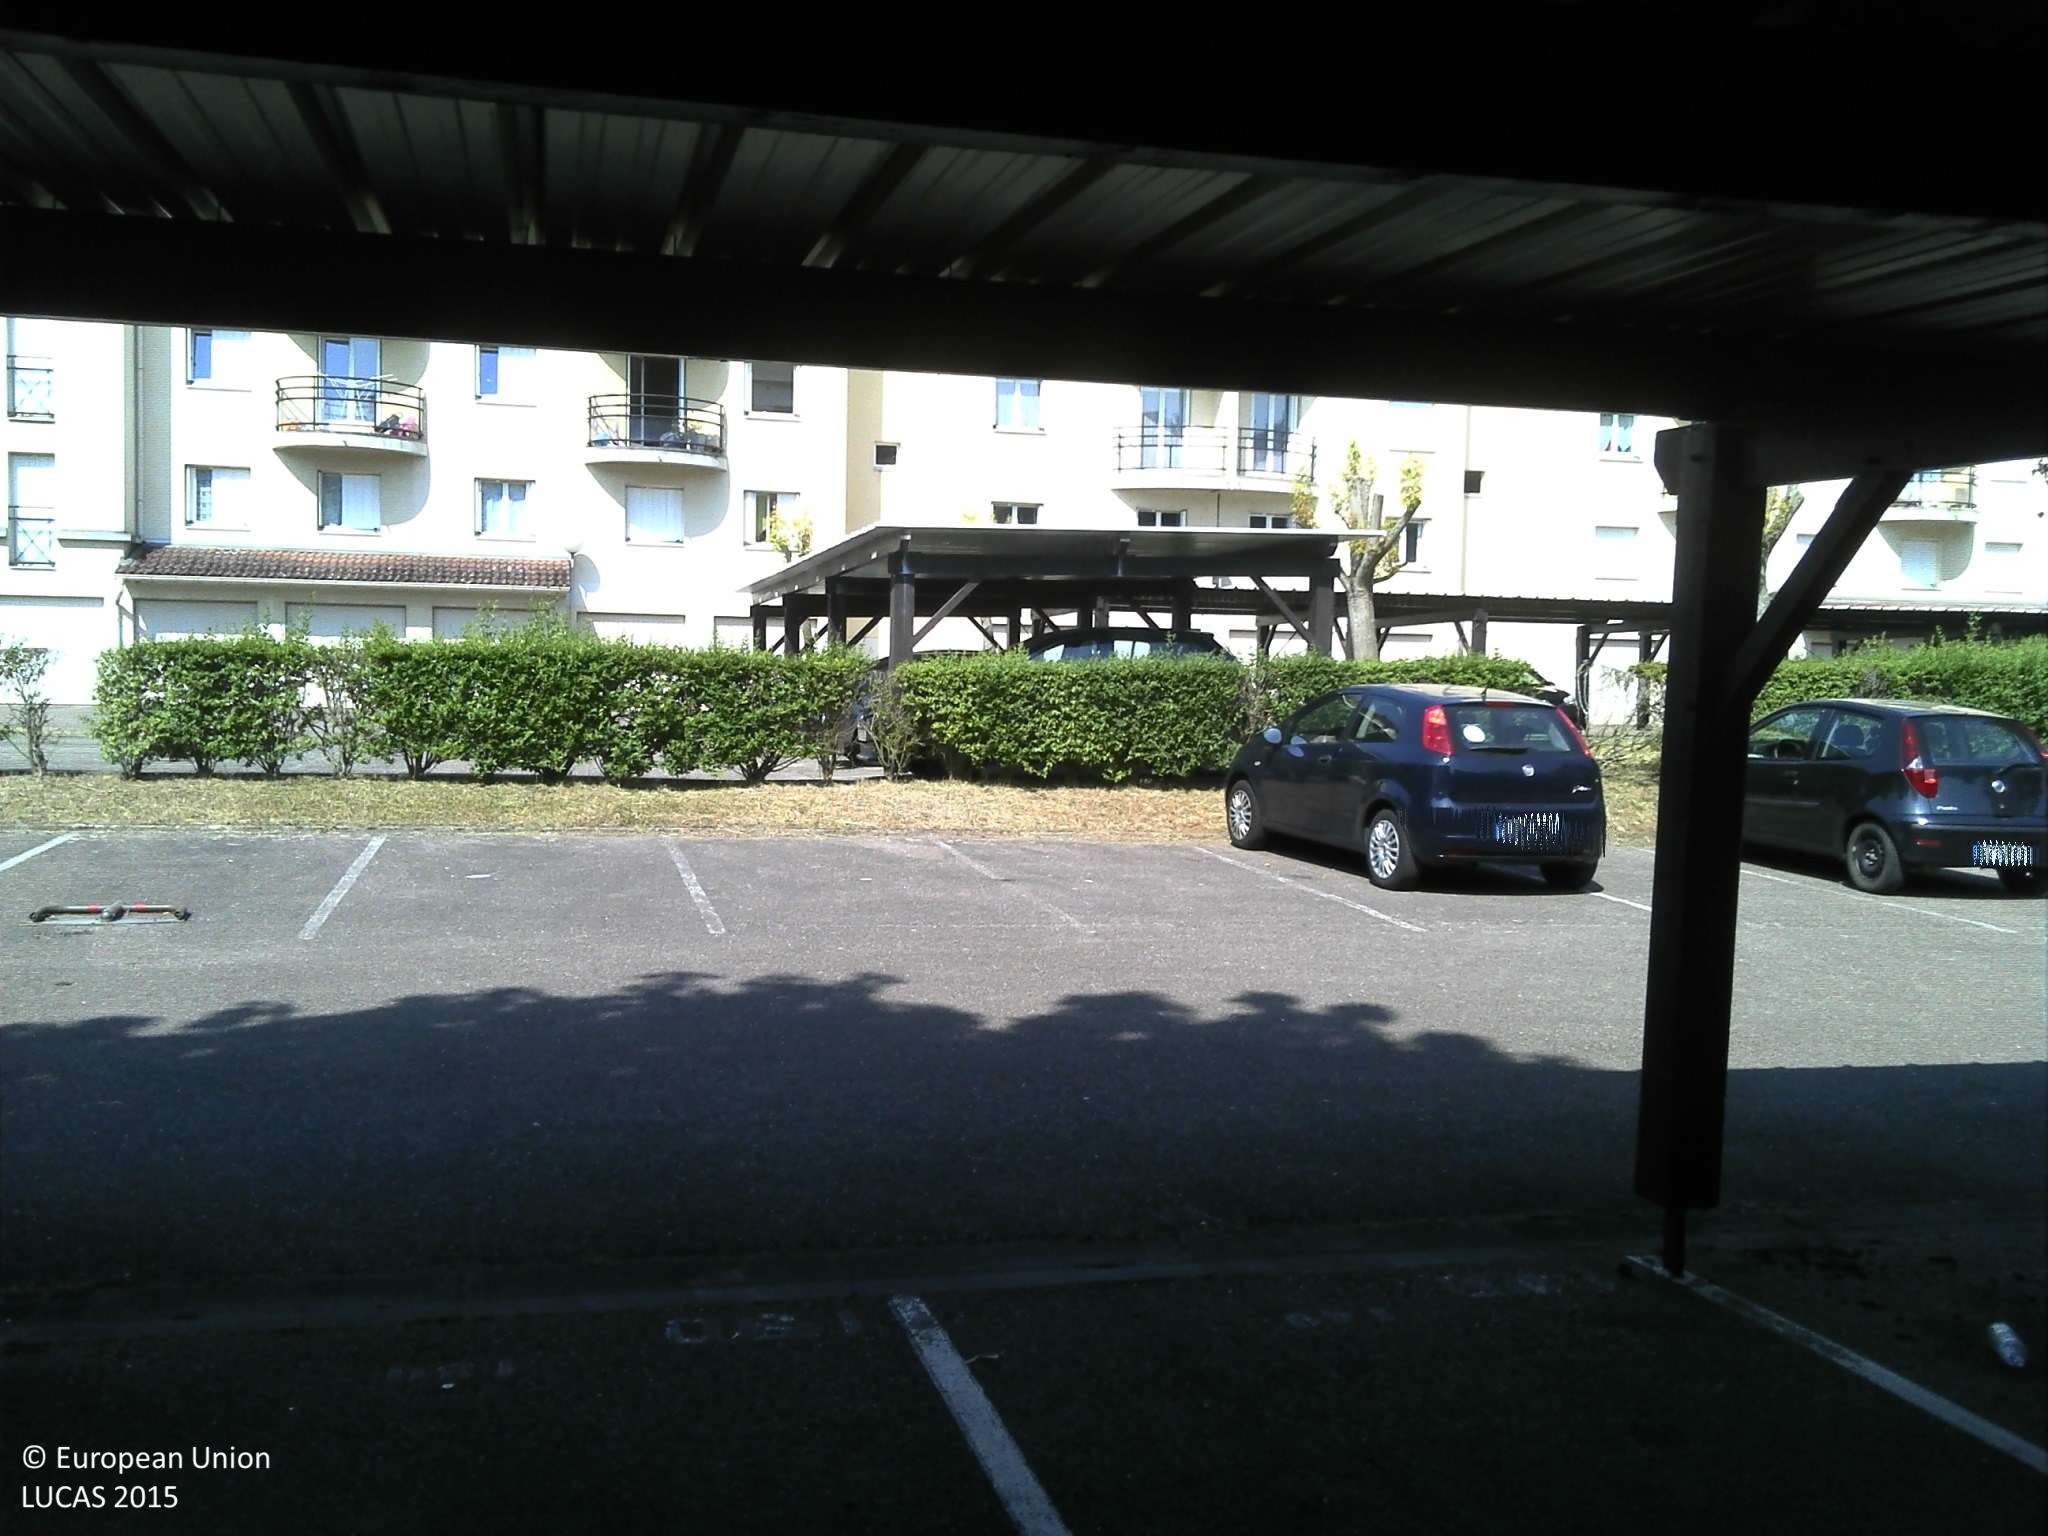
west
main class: Woodland
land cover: Broadleaved woodland
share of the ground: 25 - 50 %
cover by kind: herbaceous plants 60 %, broadleaved forest trees 40 %
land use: Residential
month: June
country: FR
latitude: 49.0939
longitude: 6.1789
